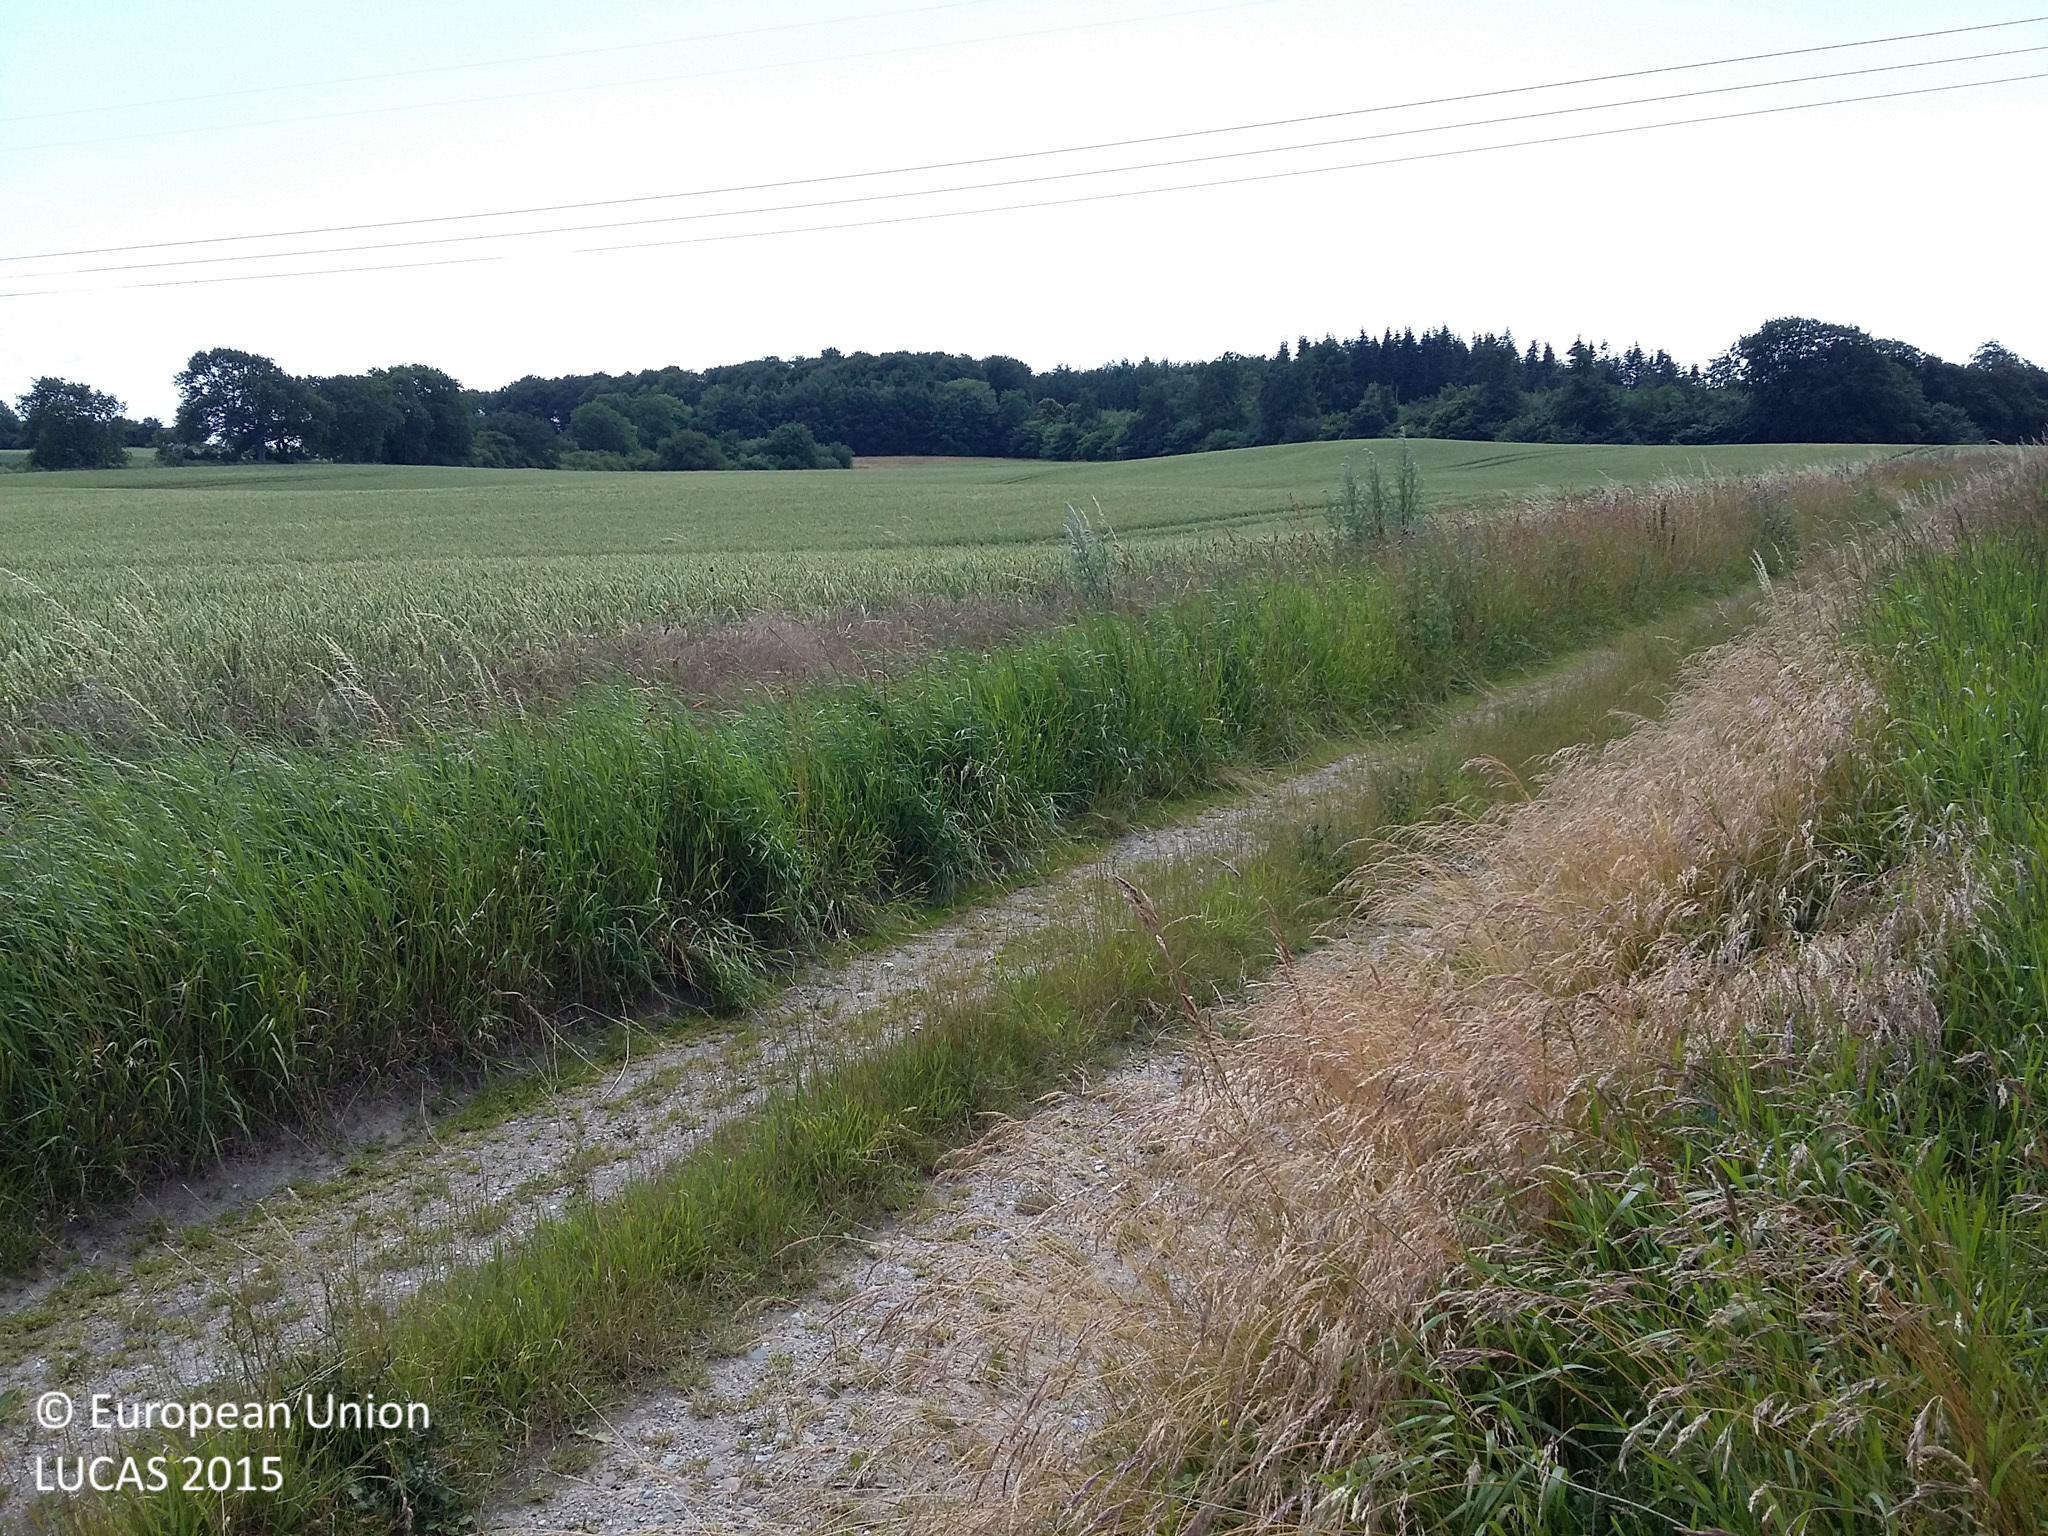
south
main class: Cropland
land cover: Common wheat
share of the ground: > 75 %
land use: Agriculture (excluding fallow land and kitchen gardens)
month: July
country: DK
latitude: 55.6240
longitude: 11.2851
